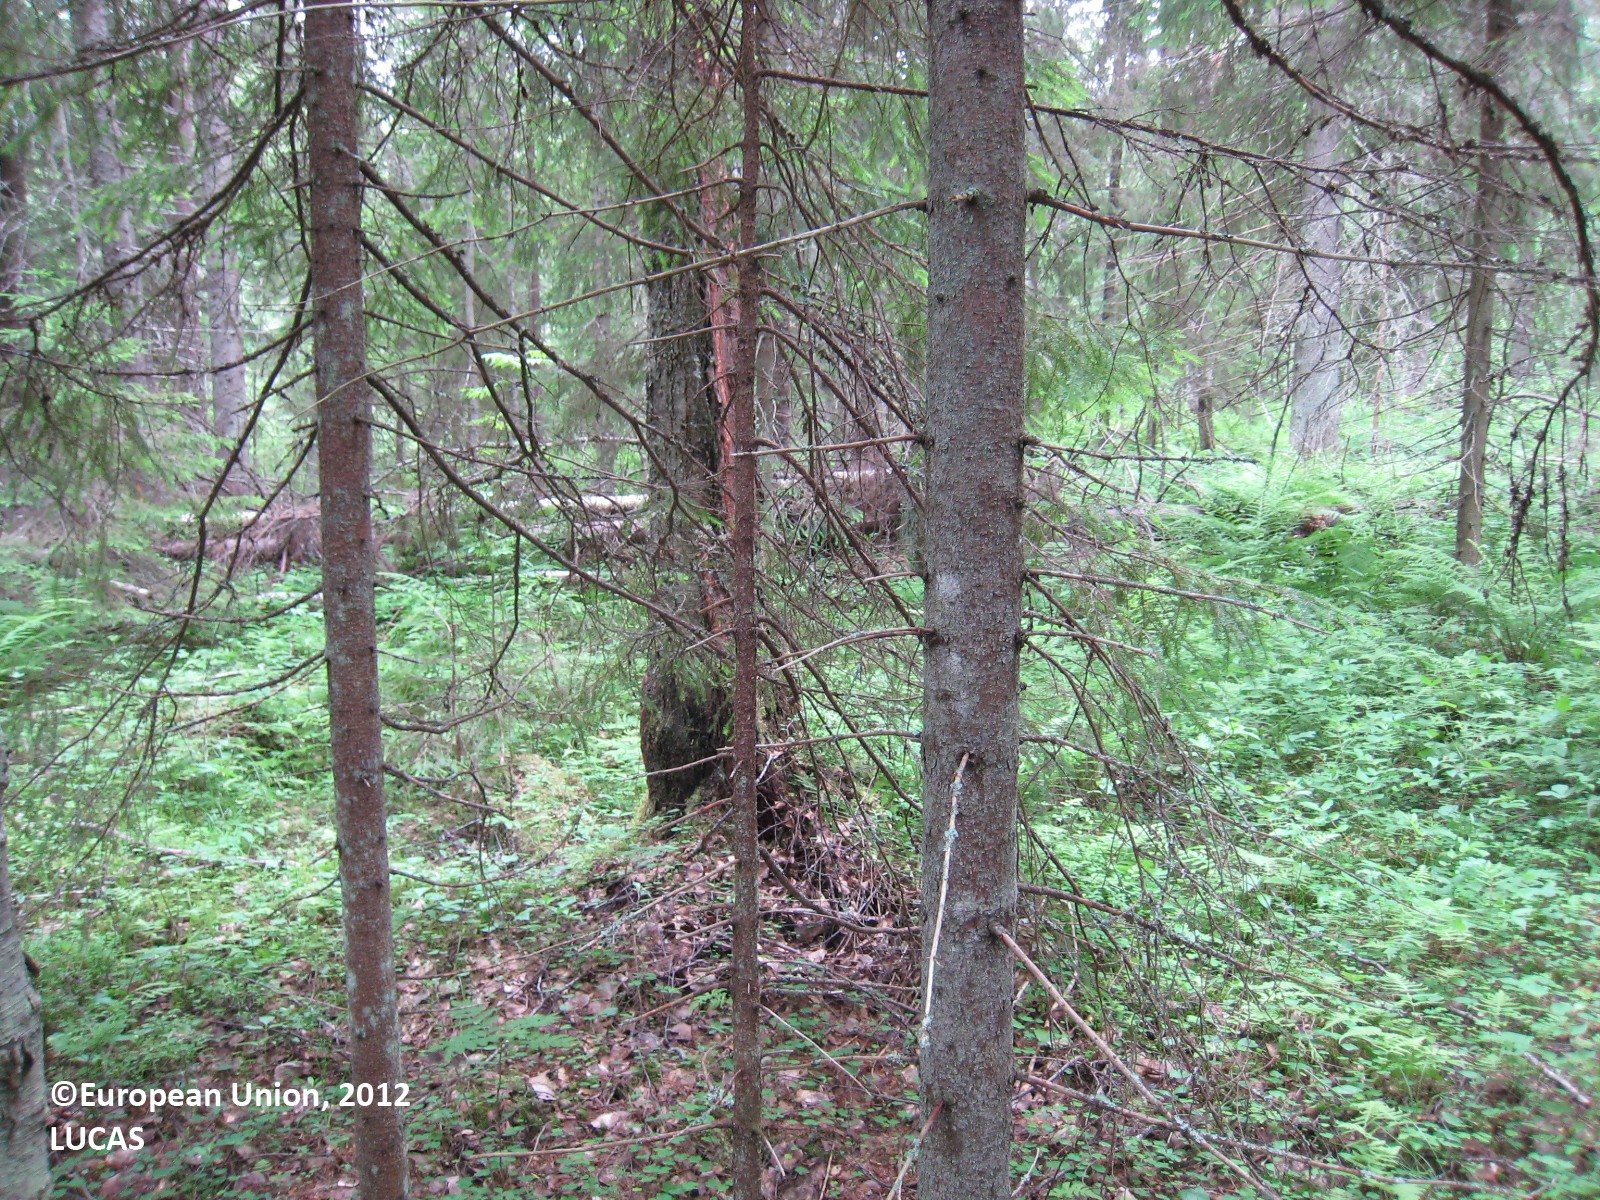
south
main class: Woodland
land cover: Spruce dominated coniferous woodland
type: boreal forest
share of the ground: 50 - 75 %
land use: Forestry
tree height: > 5 m
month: June
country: FI
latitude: 62.0653
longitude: 26.3055
